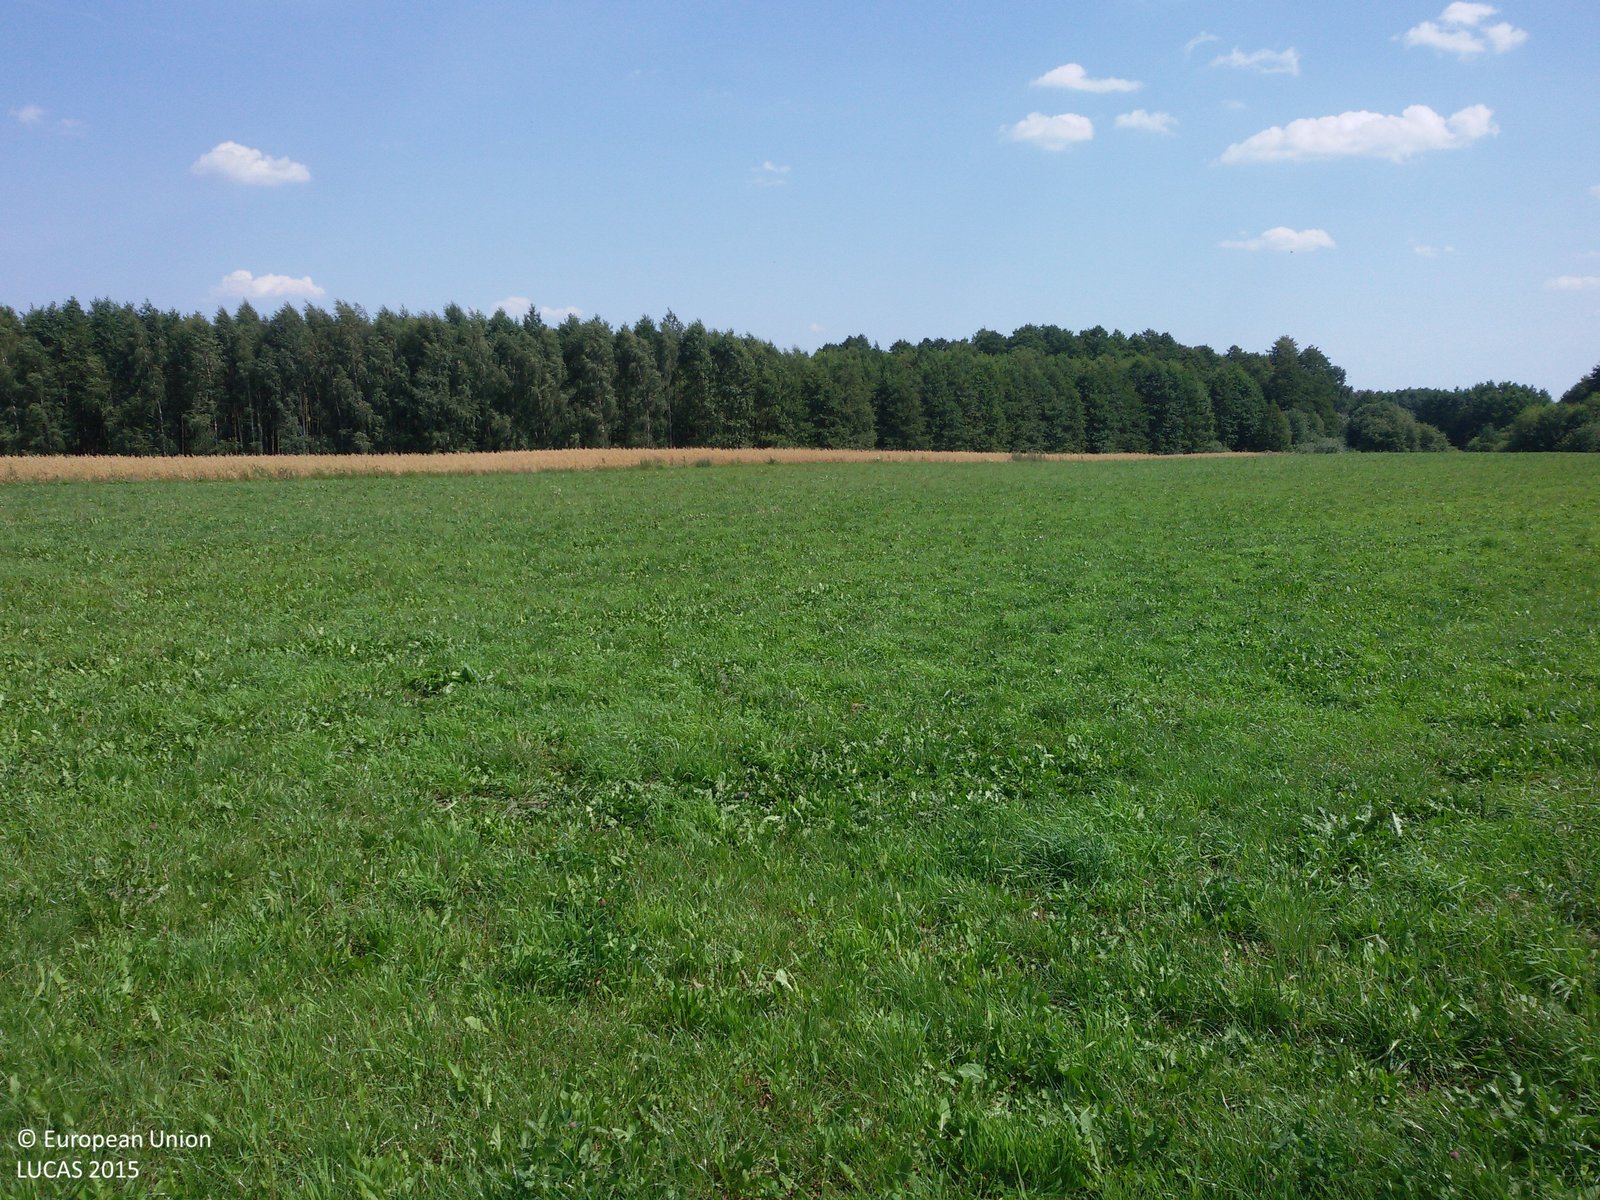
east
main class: Grassland
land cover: Grassland without tree/shrub cover
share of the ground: > 75 %
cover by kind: herbaceous plants 100 %
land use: Agriculture (excluding fallow land and kitchen gardens)
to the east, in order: Grassland without tree/shrub cover; Barley; Grass margins; Broadleaved woodland
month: August
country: PL
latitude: 53.5701
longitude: 17.7293
